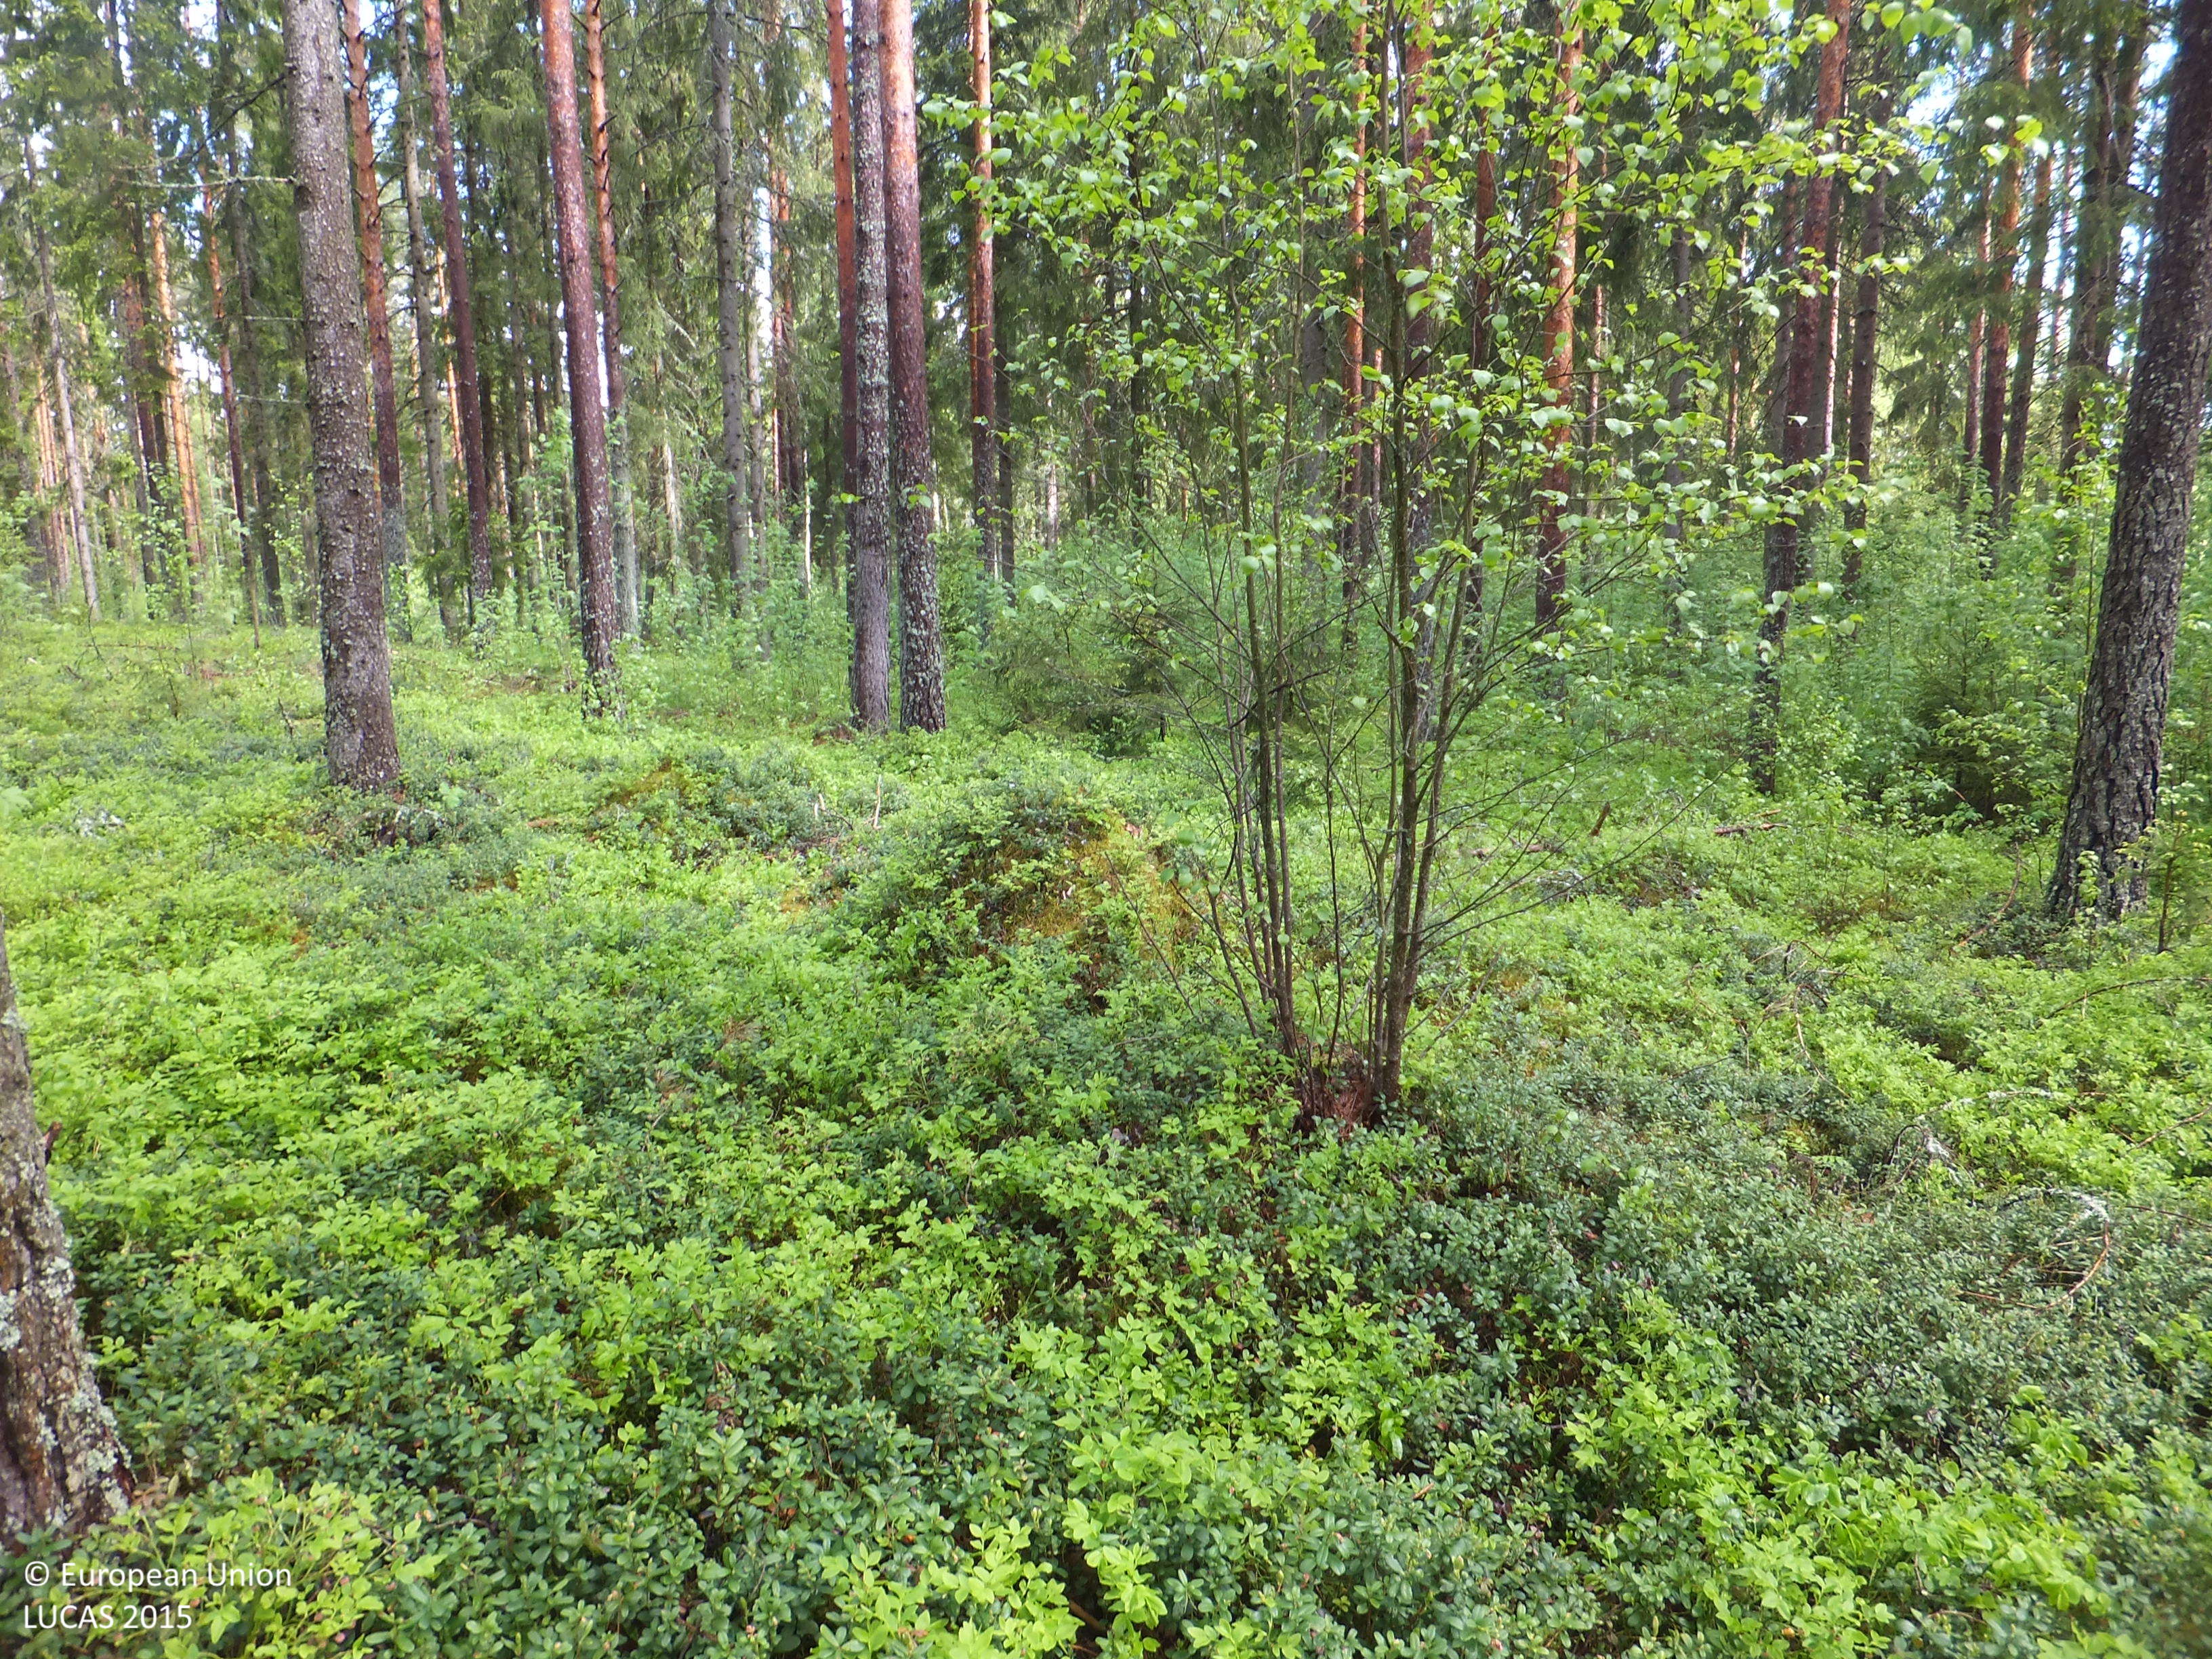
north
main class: Woodland
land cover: Pine dominated coniferous woodland
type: boreal forest
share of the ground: > 75 %
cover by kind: coniferous forest trees 75 %, shrubs 15 %, lichens and mosses 10 %
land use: Forestry
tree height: > 5 m
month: June
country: FI
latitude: 63.5562
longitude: 22.9138
